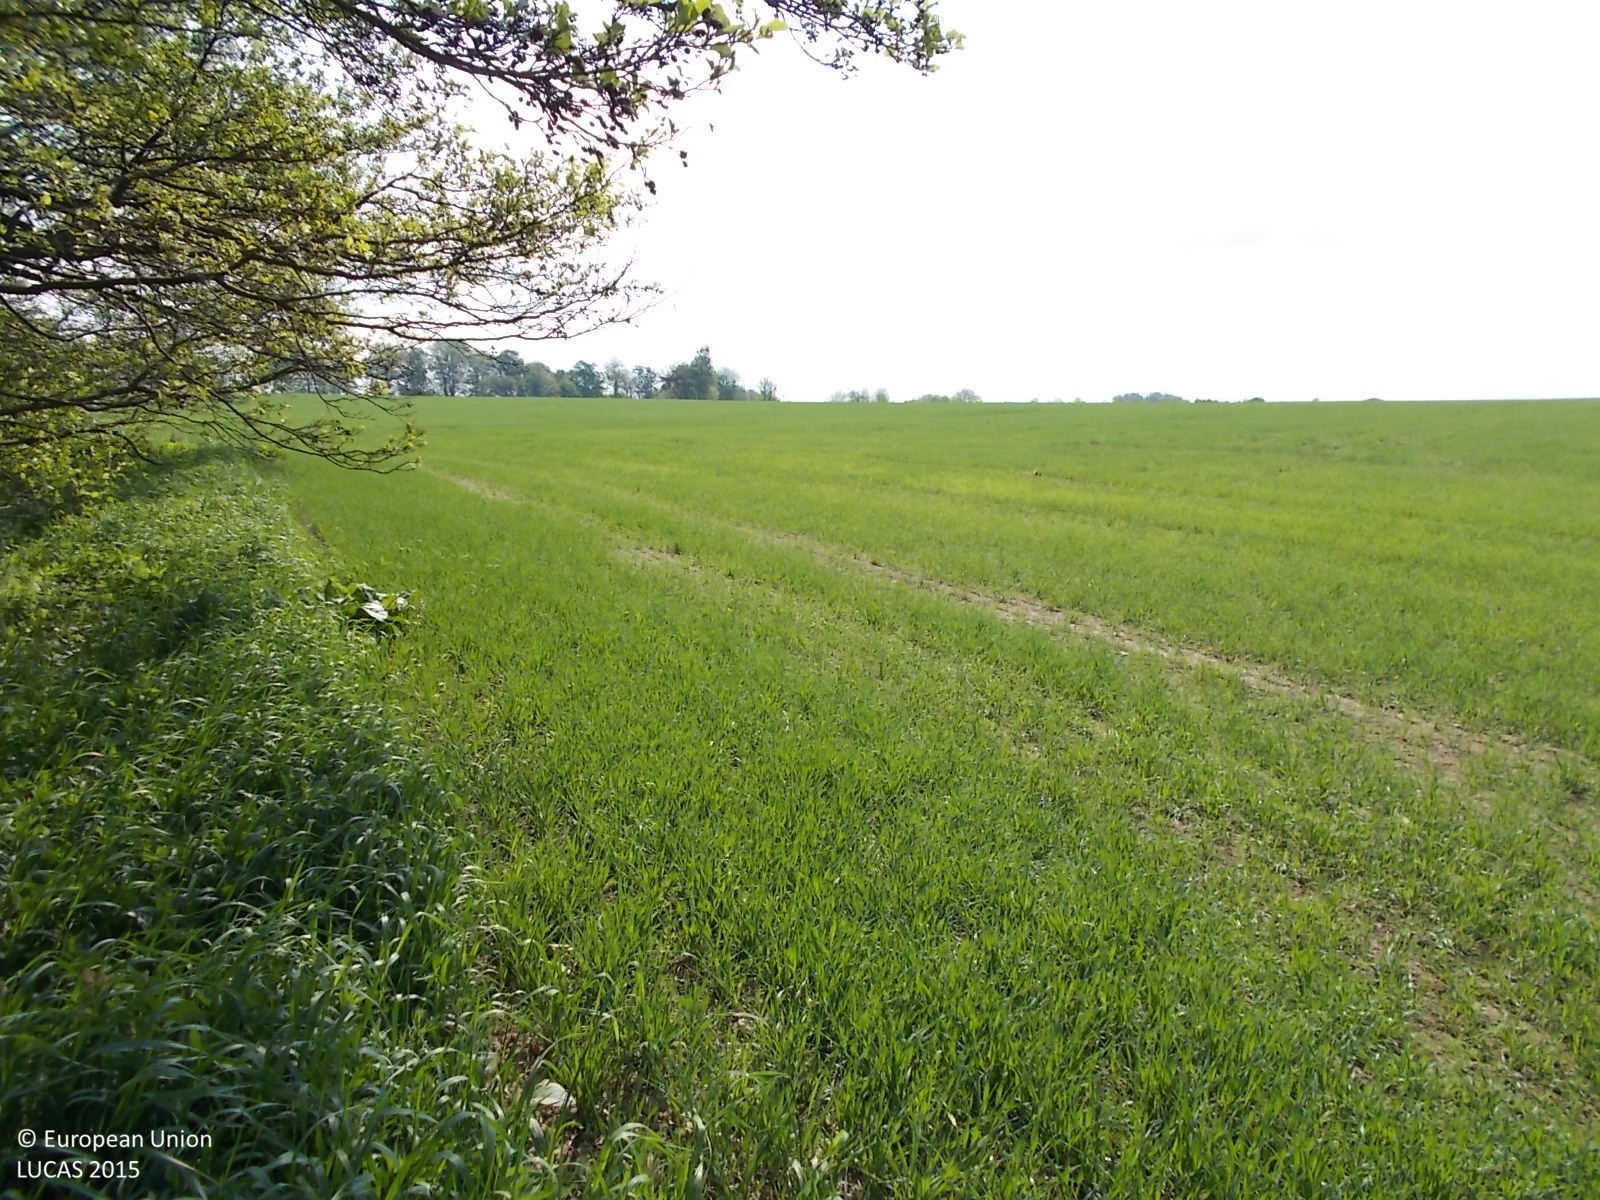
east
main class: Woodland
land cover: Broadleaved woodland
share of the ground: > 75 %
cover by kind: broadleaved forest trees 80 %, herbaceous plants 20 %
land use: Semi-natural and natural areas not in use
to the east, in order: Broadleaved woodland; Barley
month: May
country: CZ
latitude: 49.6521
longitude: 15.5583
